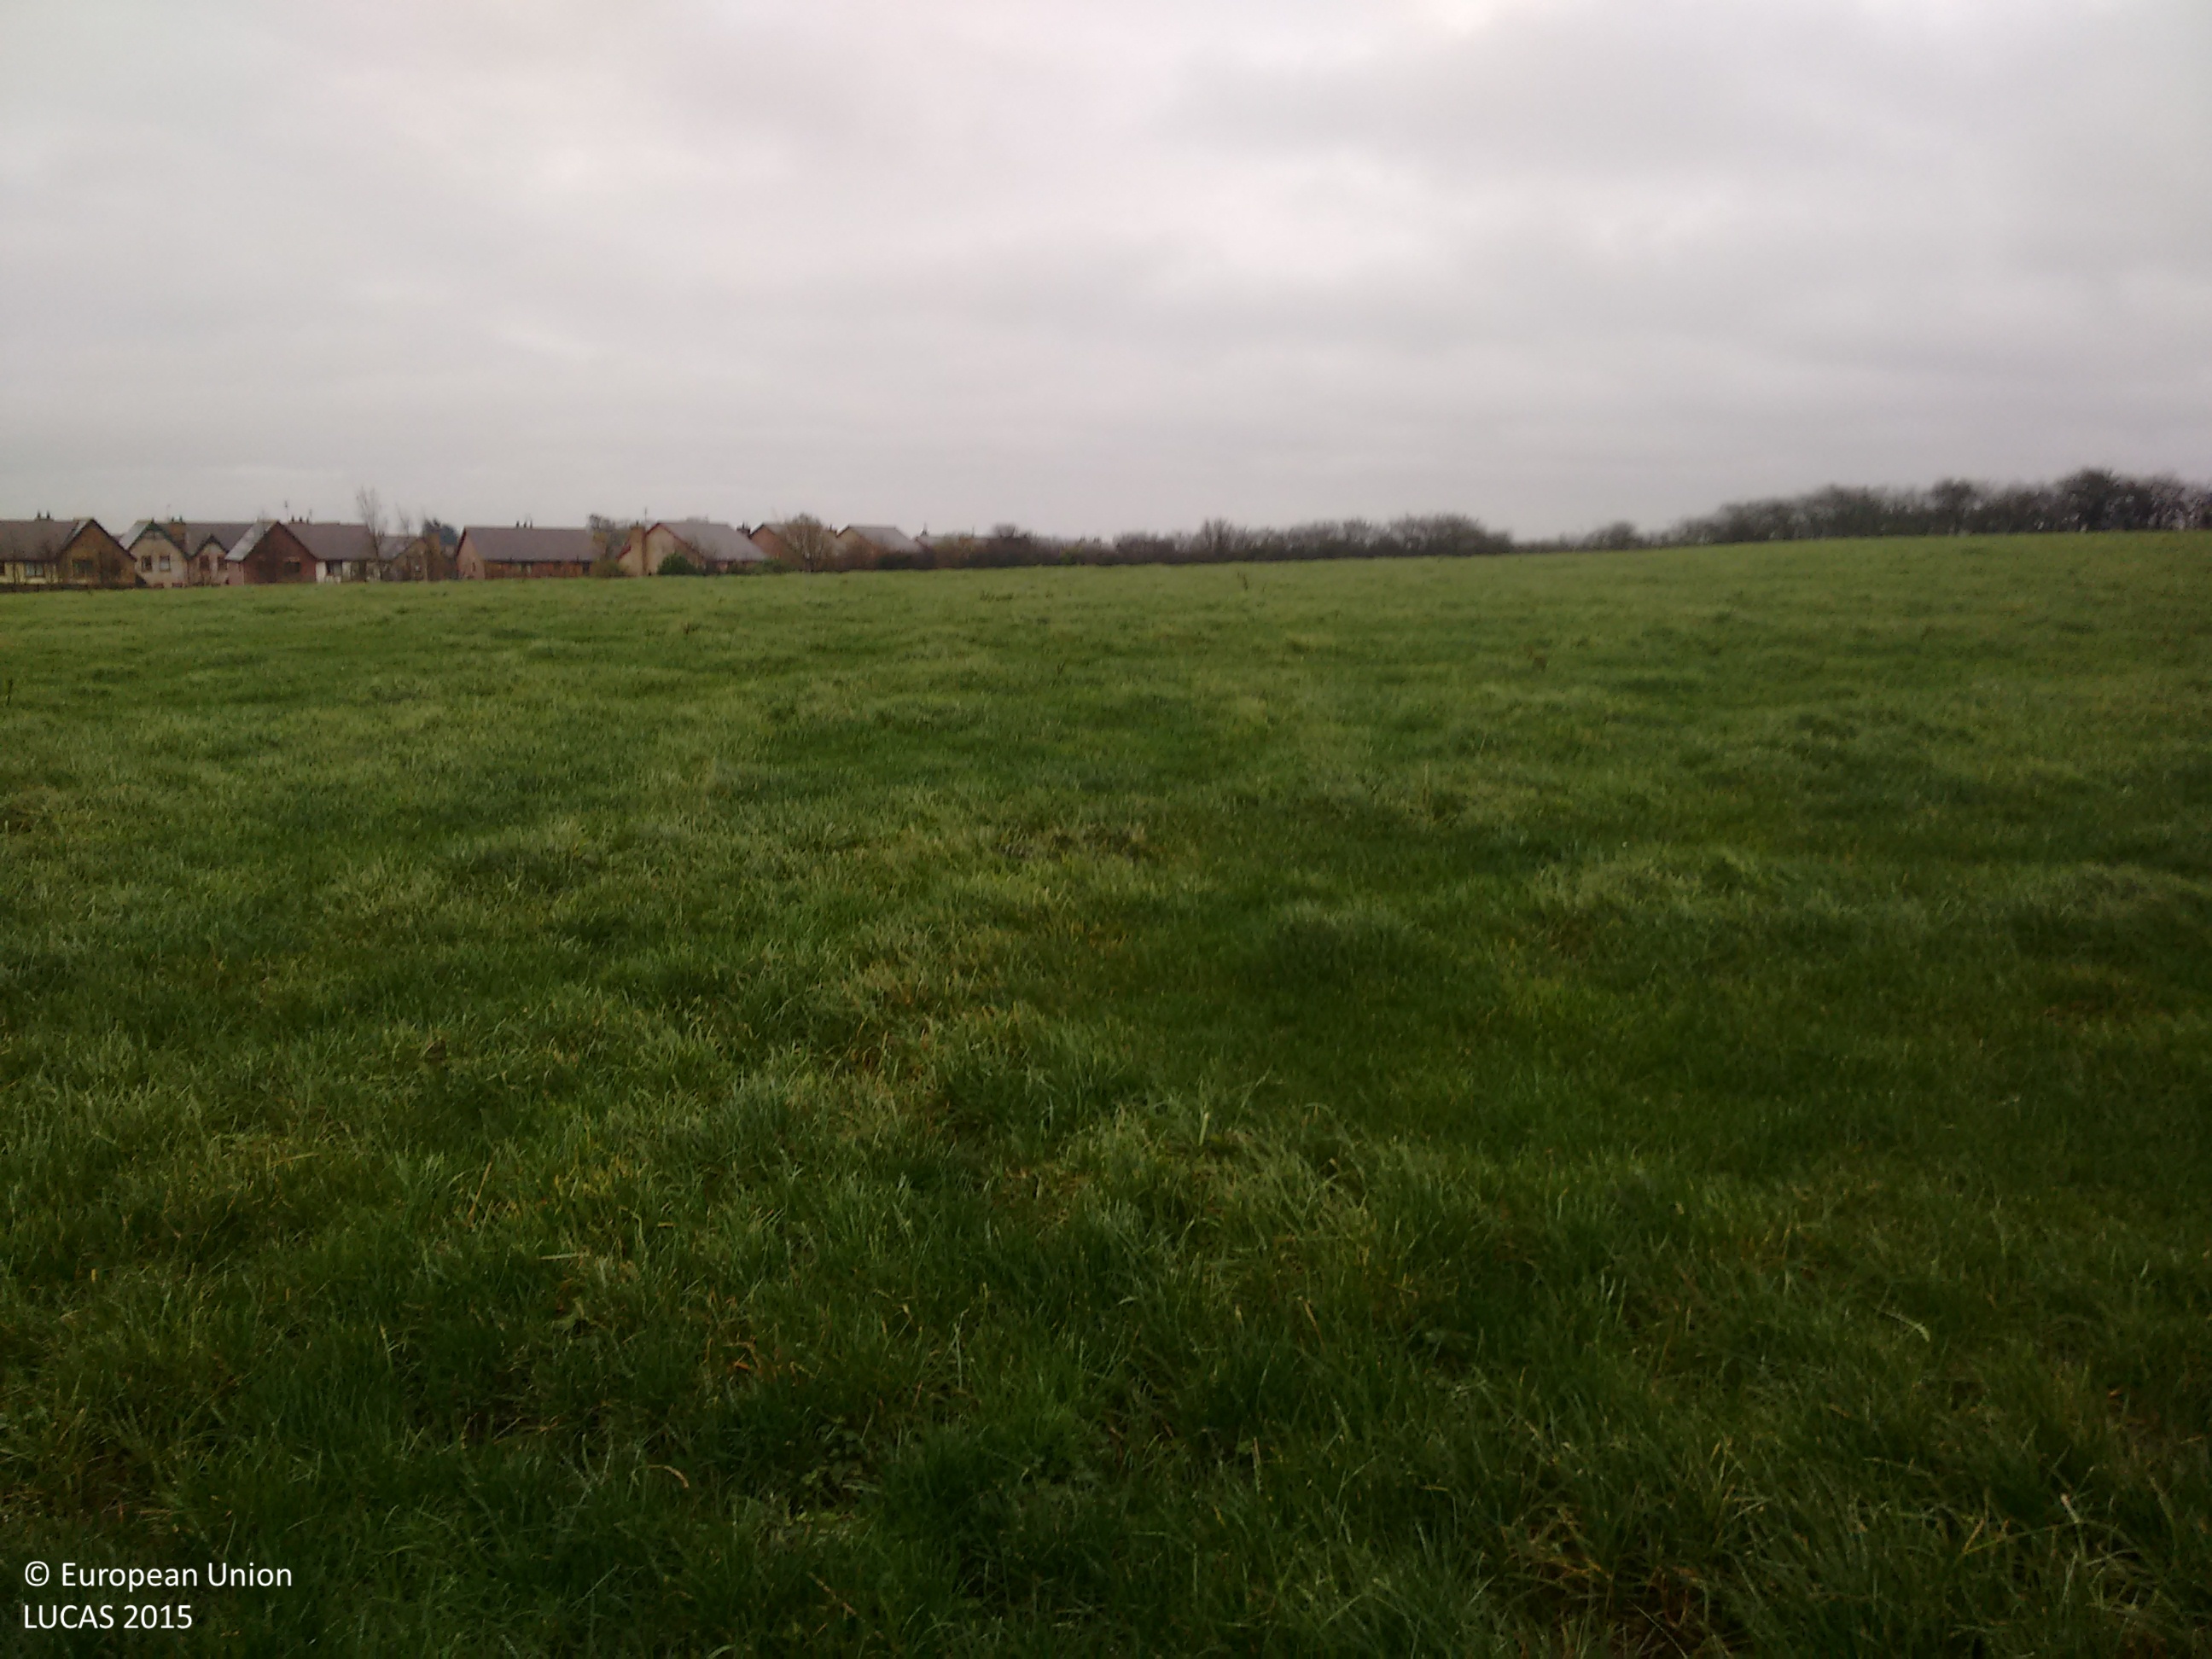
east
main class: Grassland
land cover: Grassland without tree/shrub cover
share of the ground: > 75 %
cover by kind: herbaceous plants 100 %
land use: Agriculture (excluding fallow land and kitchen gardens)
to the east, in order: Grassland without tree/shrub cover; Abandoned hedges; Fences; Grassland without tree/shrub cover; Abandoned hedges; Grassland without tree/shrub cover
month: November
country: GB
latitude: 54.6290
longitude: -5.6682
